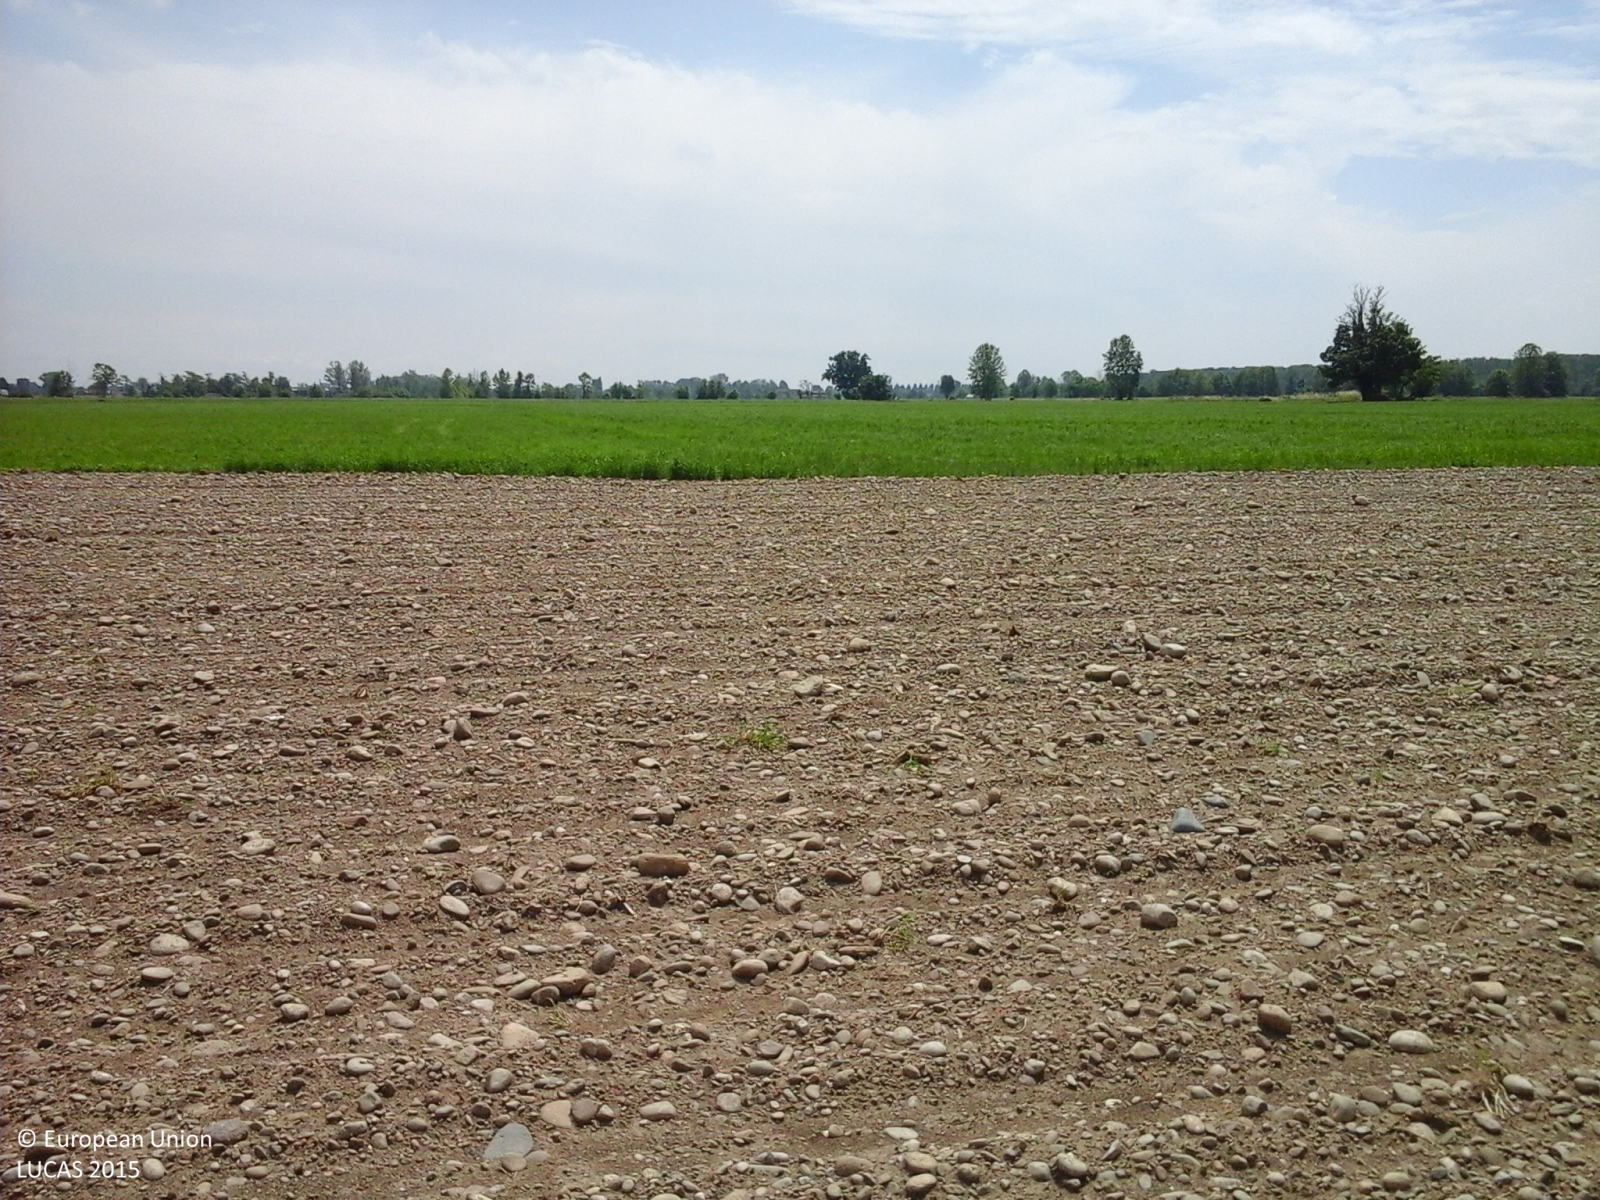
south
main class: Cropland
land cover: Maize
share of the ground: < 10 %
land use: Agriculture (excluding fallow land and kitchen gardens)
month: May
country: IT
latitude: 45.4674
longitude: 9.5531
